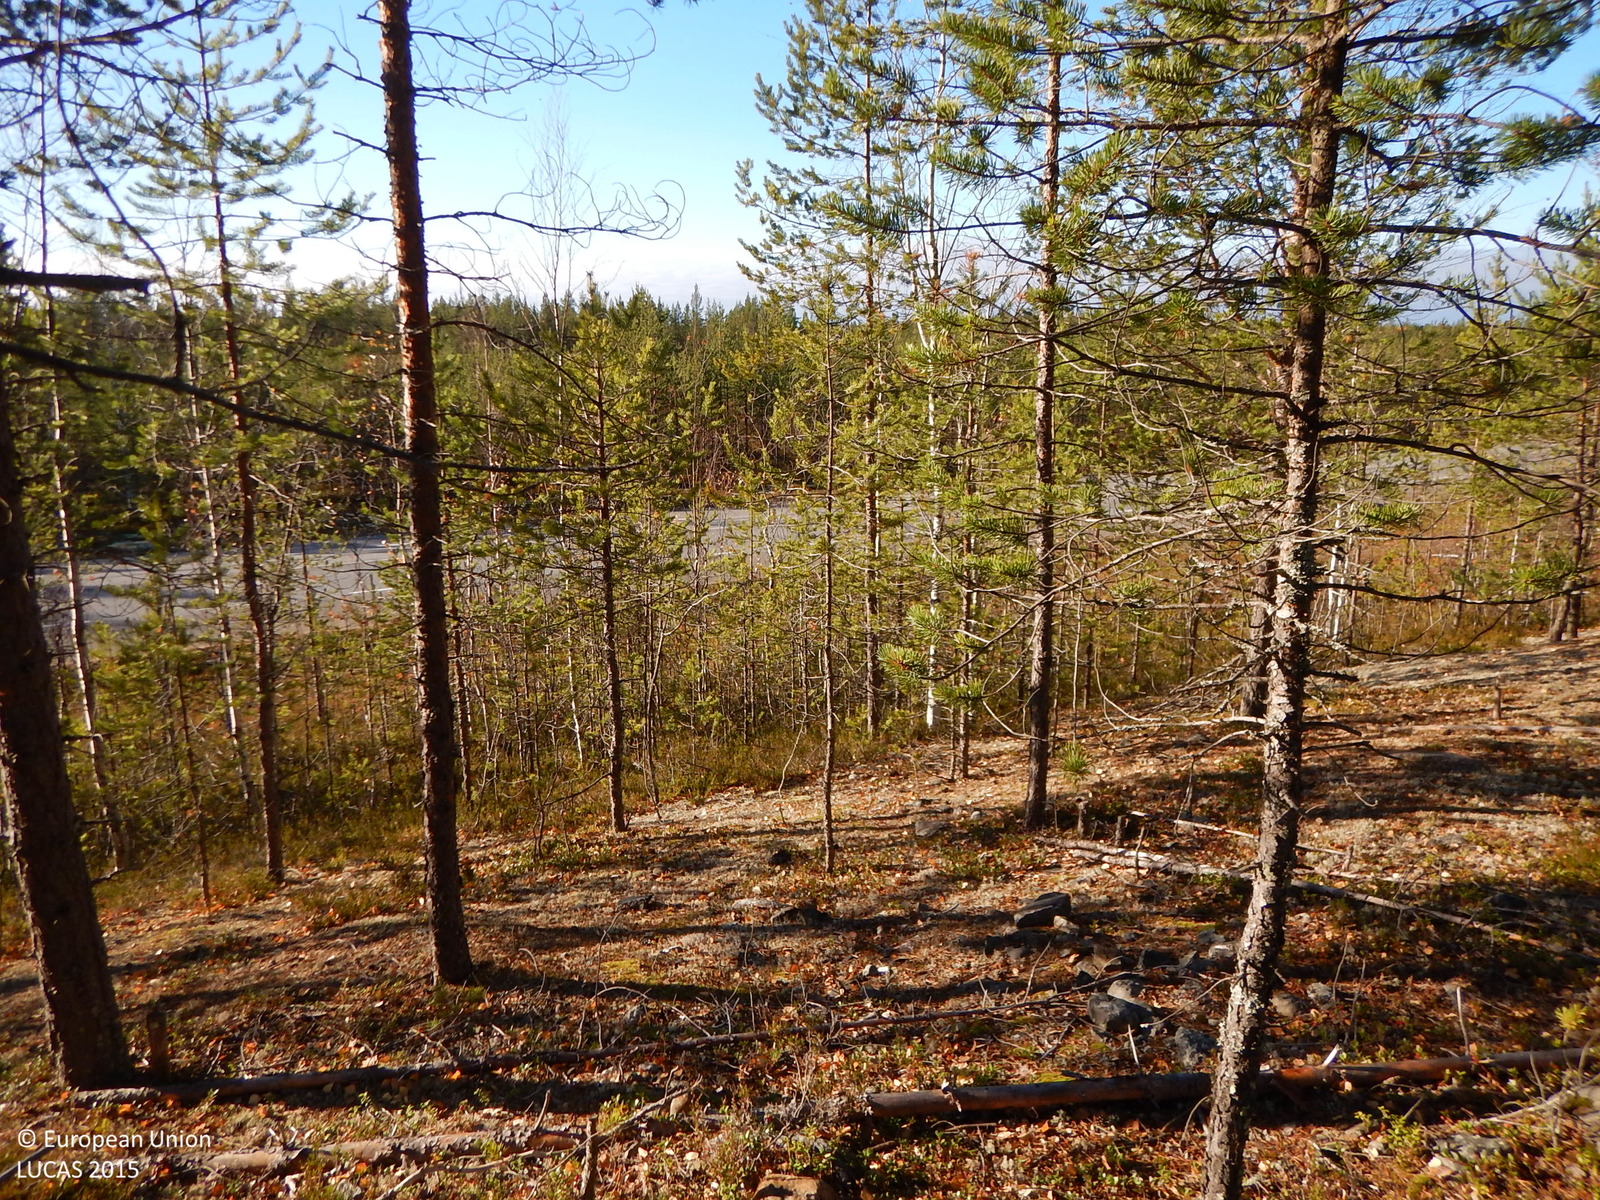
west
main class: Woodland
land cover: Pine dominated coniferous woodland
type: boreal forest
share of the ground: 50 - 75 %
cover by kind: coniferous forest trees 60 %, shrubs 20 %, lichens and mosses 20 %
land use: Forestry
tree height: > 5 m
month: October
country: SE
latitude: 65.0861
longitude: 21.1025
